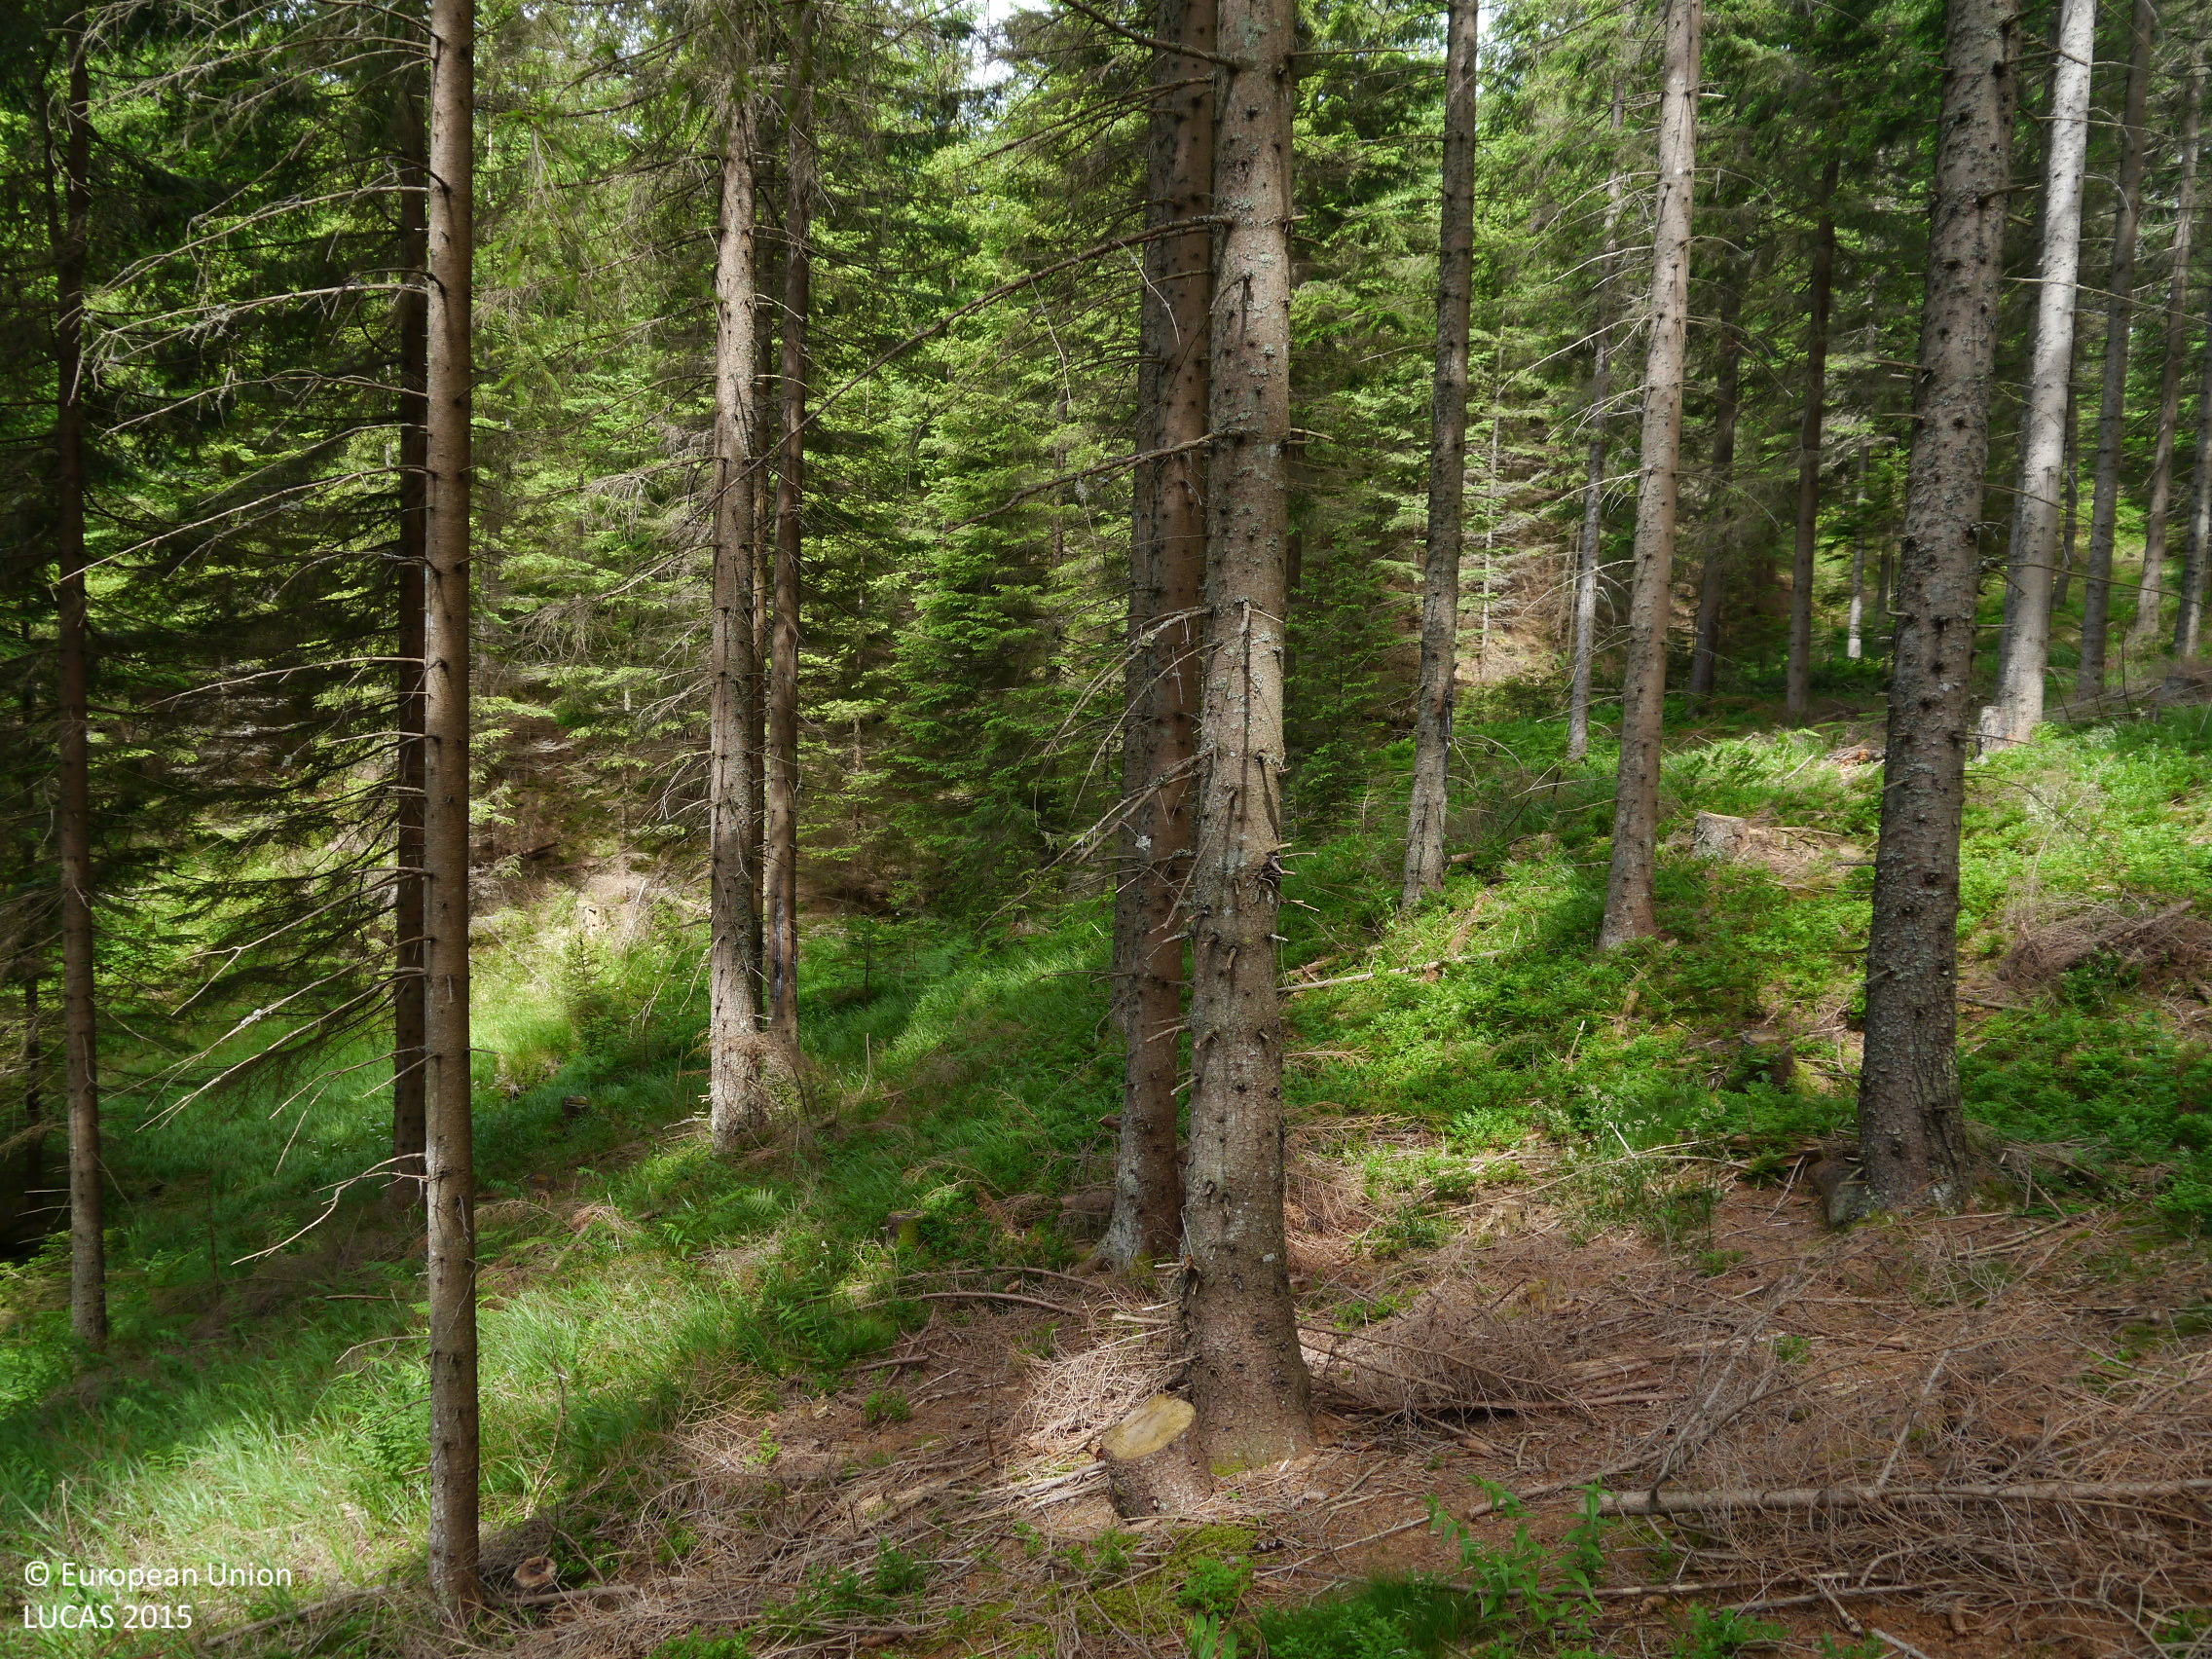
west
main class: Woodland
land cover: Spruce dominated coniferous woodland
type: alpine coniferous forest
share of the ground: > 75 %
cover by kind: coniferous forest trees 70 %, shrubs 20 %, herbaceous plants 10 %
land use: Forestry
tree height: > 5 m
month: June
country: AT
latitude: 46.7353
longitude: 15.0893
